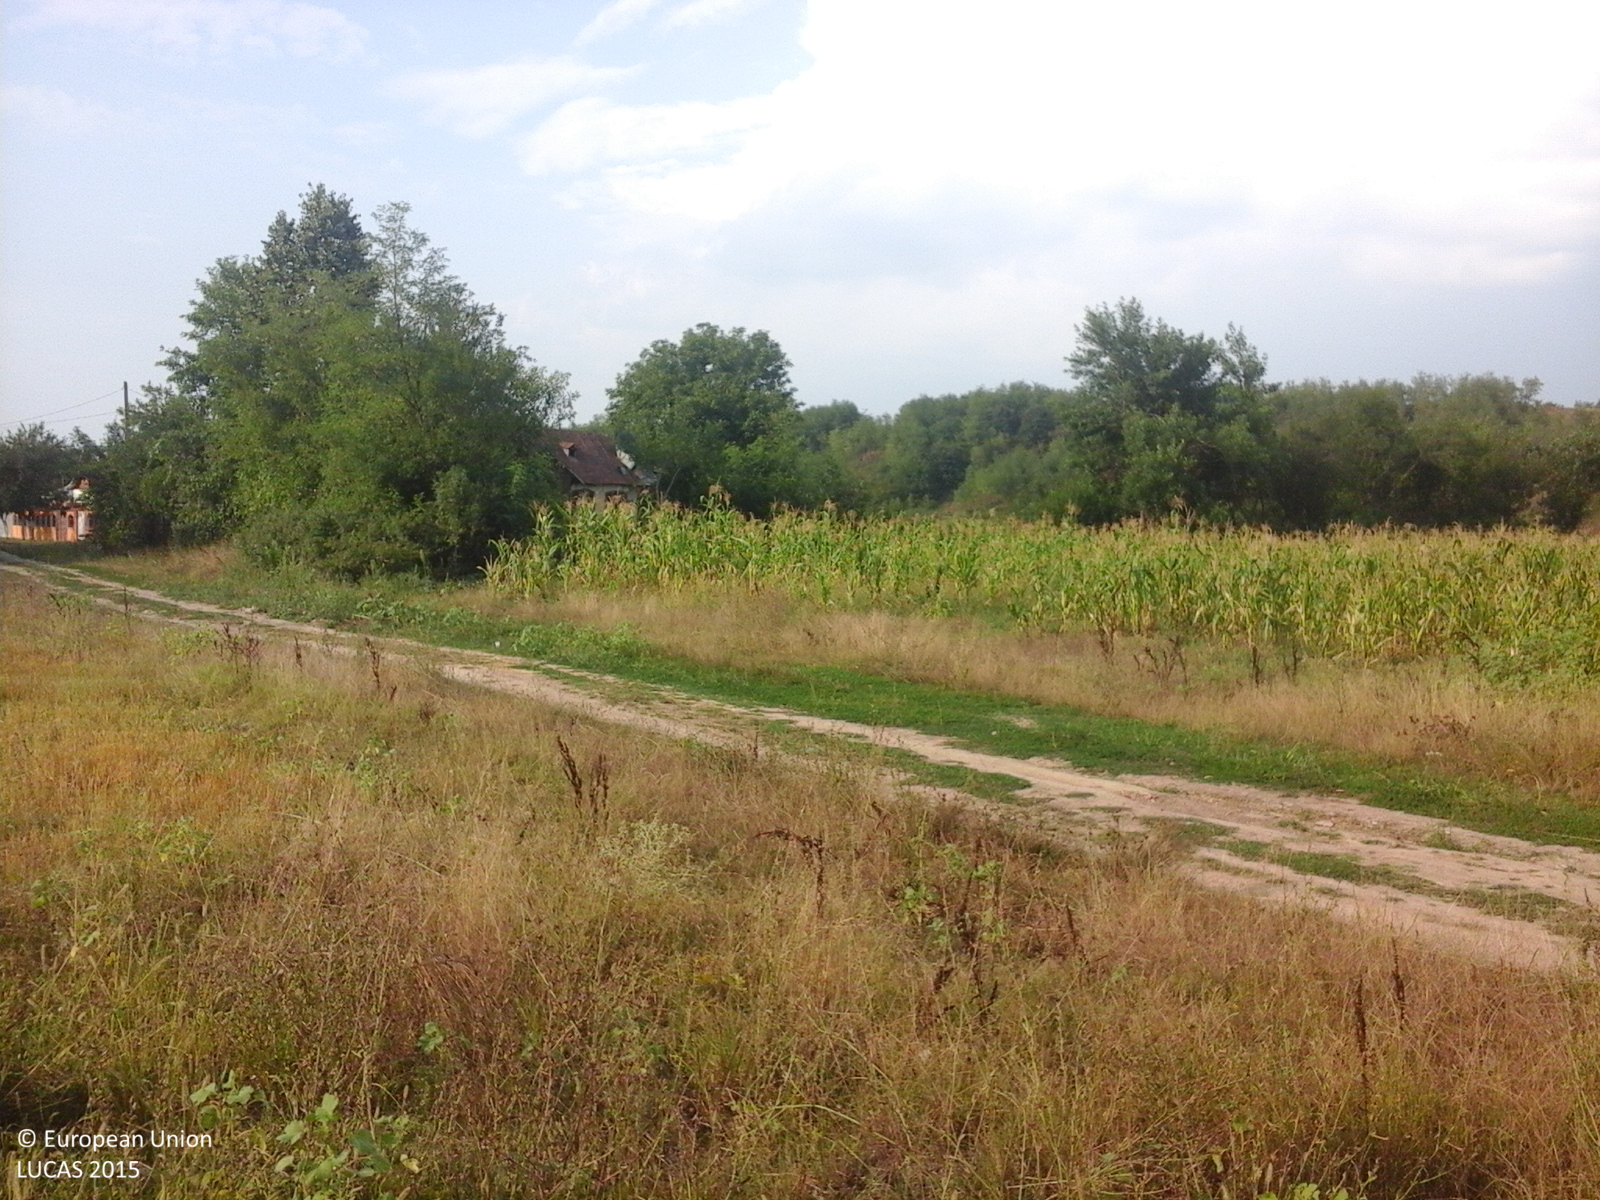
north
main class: Cropland
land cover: Maize
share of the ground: > 75 %
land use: Agriculture (excluding fallow land and kitchen gardens)
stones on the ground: < 10 %
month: August
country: RO
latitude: 44.6865
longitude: 23.6461
